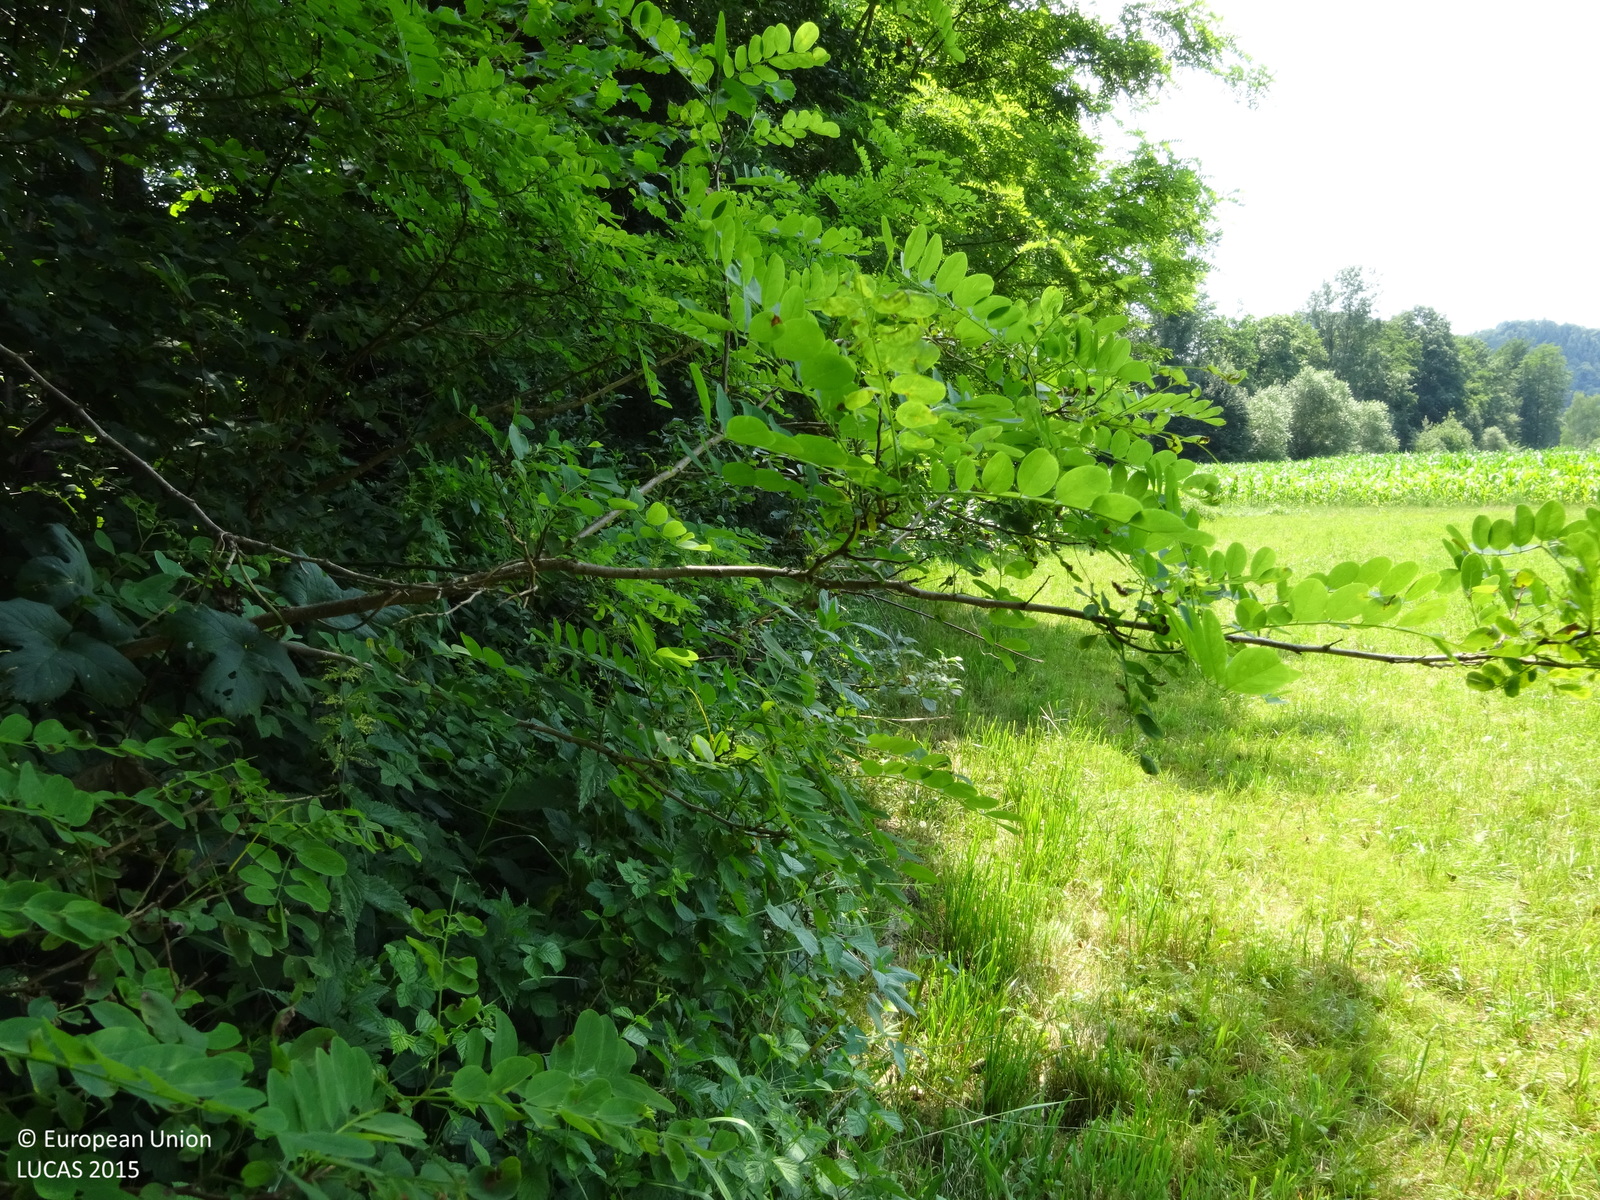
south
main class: Woodland
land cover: Broadleaved woodland
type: floodplain forest
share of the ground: 25 - 50 %
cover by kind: broadleaved forest trees 50 %, shrubs 50 %
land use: Forestry
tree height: > 5 m
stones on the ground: 10 - 25 %
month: July
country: AT
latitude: 46.9258
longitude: 15.9500
